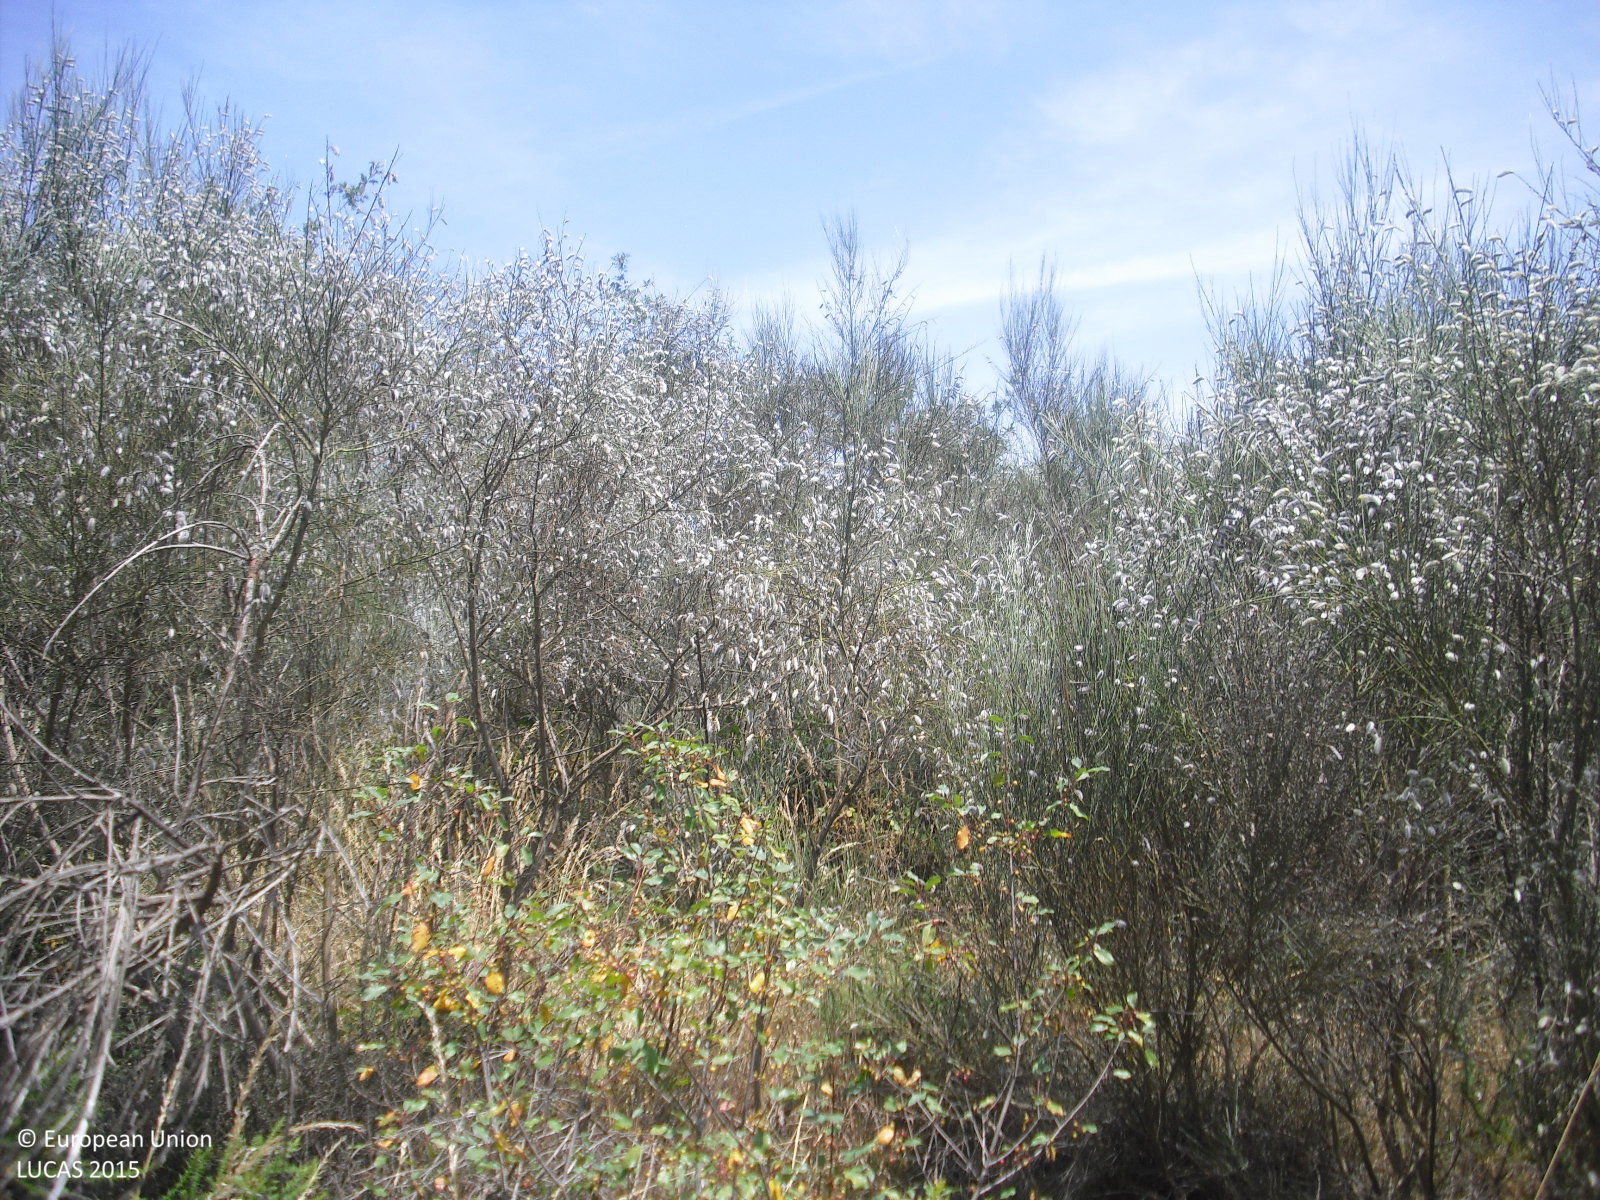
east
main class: Shrubland
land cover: Shrubland without tree cover
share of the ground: 50 - 75 %
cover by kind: shrubs 70 %, herbaceous plants 30 %
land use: Abandoned areas
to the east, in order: Shrubland without tree cover; Tracks; Shrubland with sparse tree cover; Grassland without tree/shrub cover; Artificial constructions; Grassland with sparse tree/shrub cover; Artificial constructions; Grass margins; Tracks; Grass margins; Fences; Grassland with sparse tree/shrub cover; Other fruit trees and berries; Artificial constructions in urban areas; Managed hedges; Vineyards; Fences; Grassland without tree/shrub cover; Ditches and canals; Paved roads, cycling and walking lanes
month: July
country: ES
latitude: 42.4979
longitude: -7.5062
